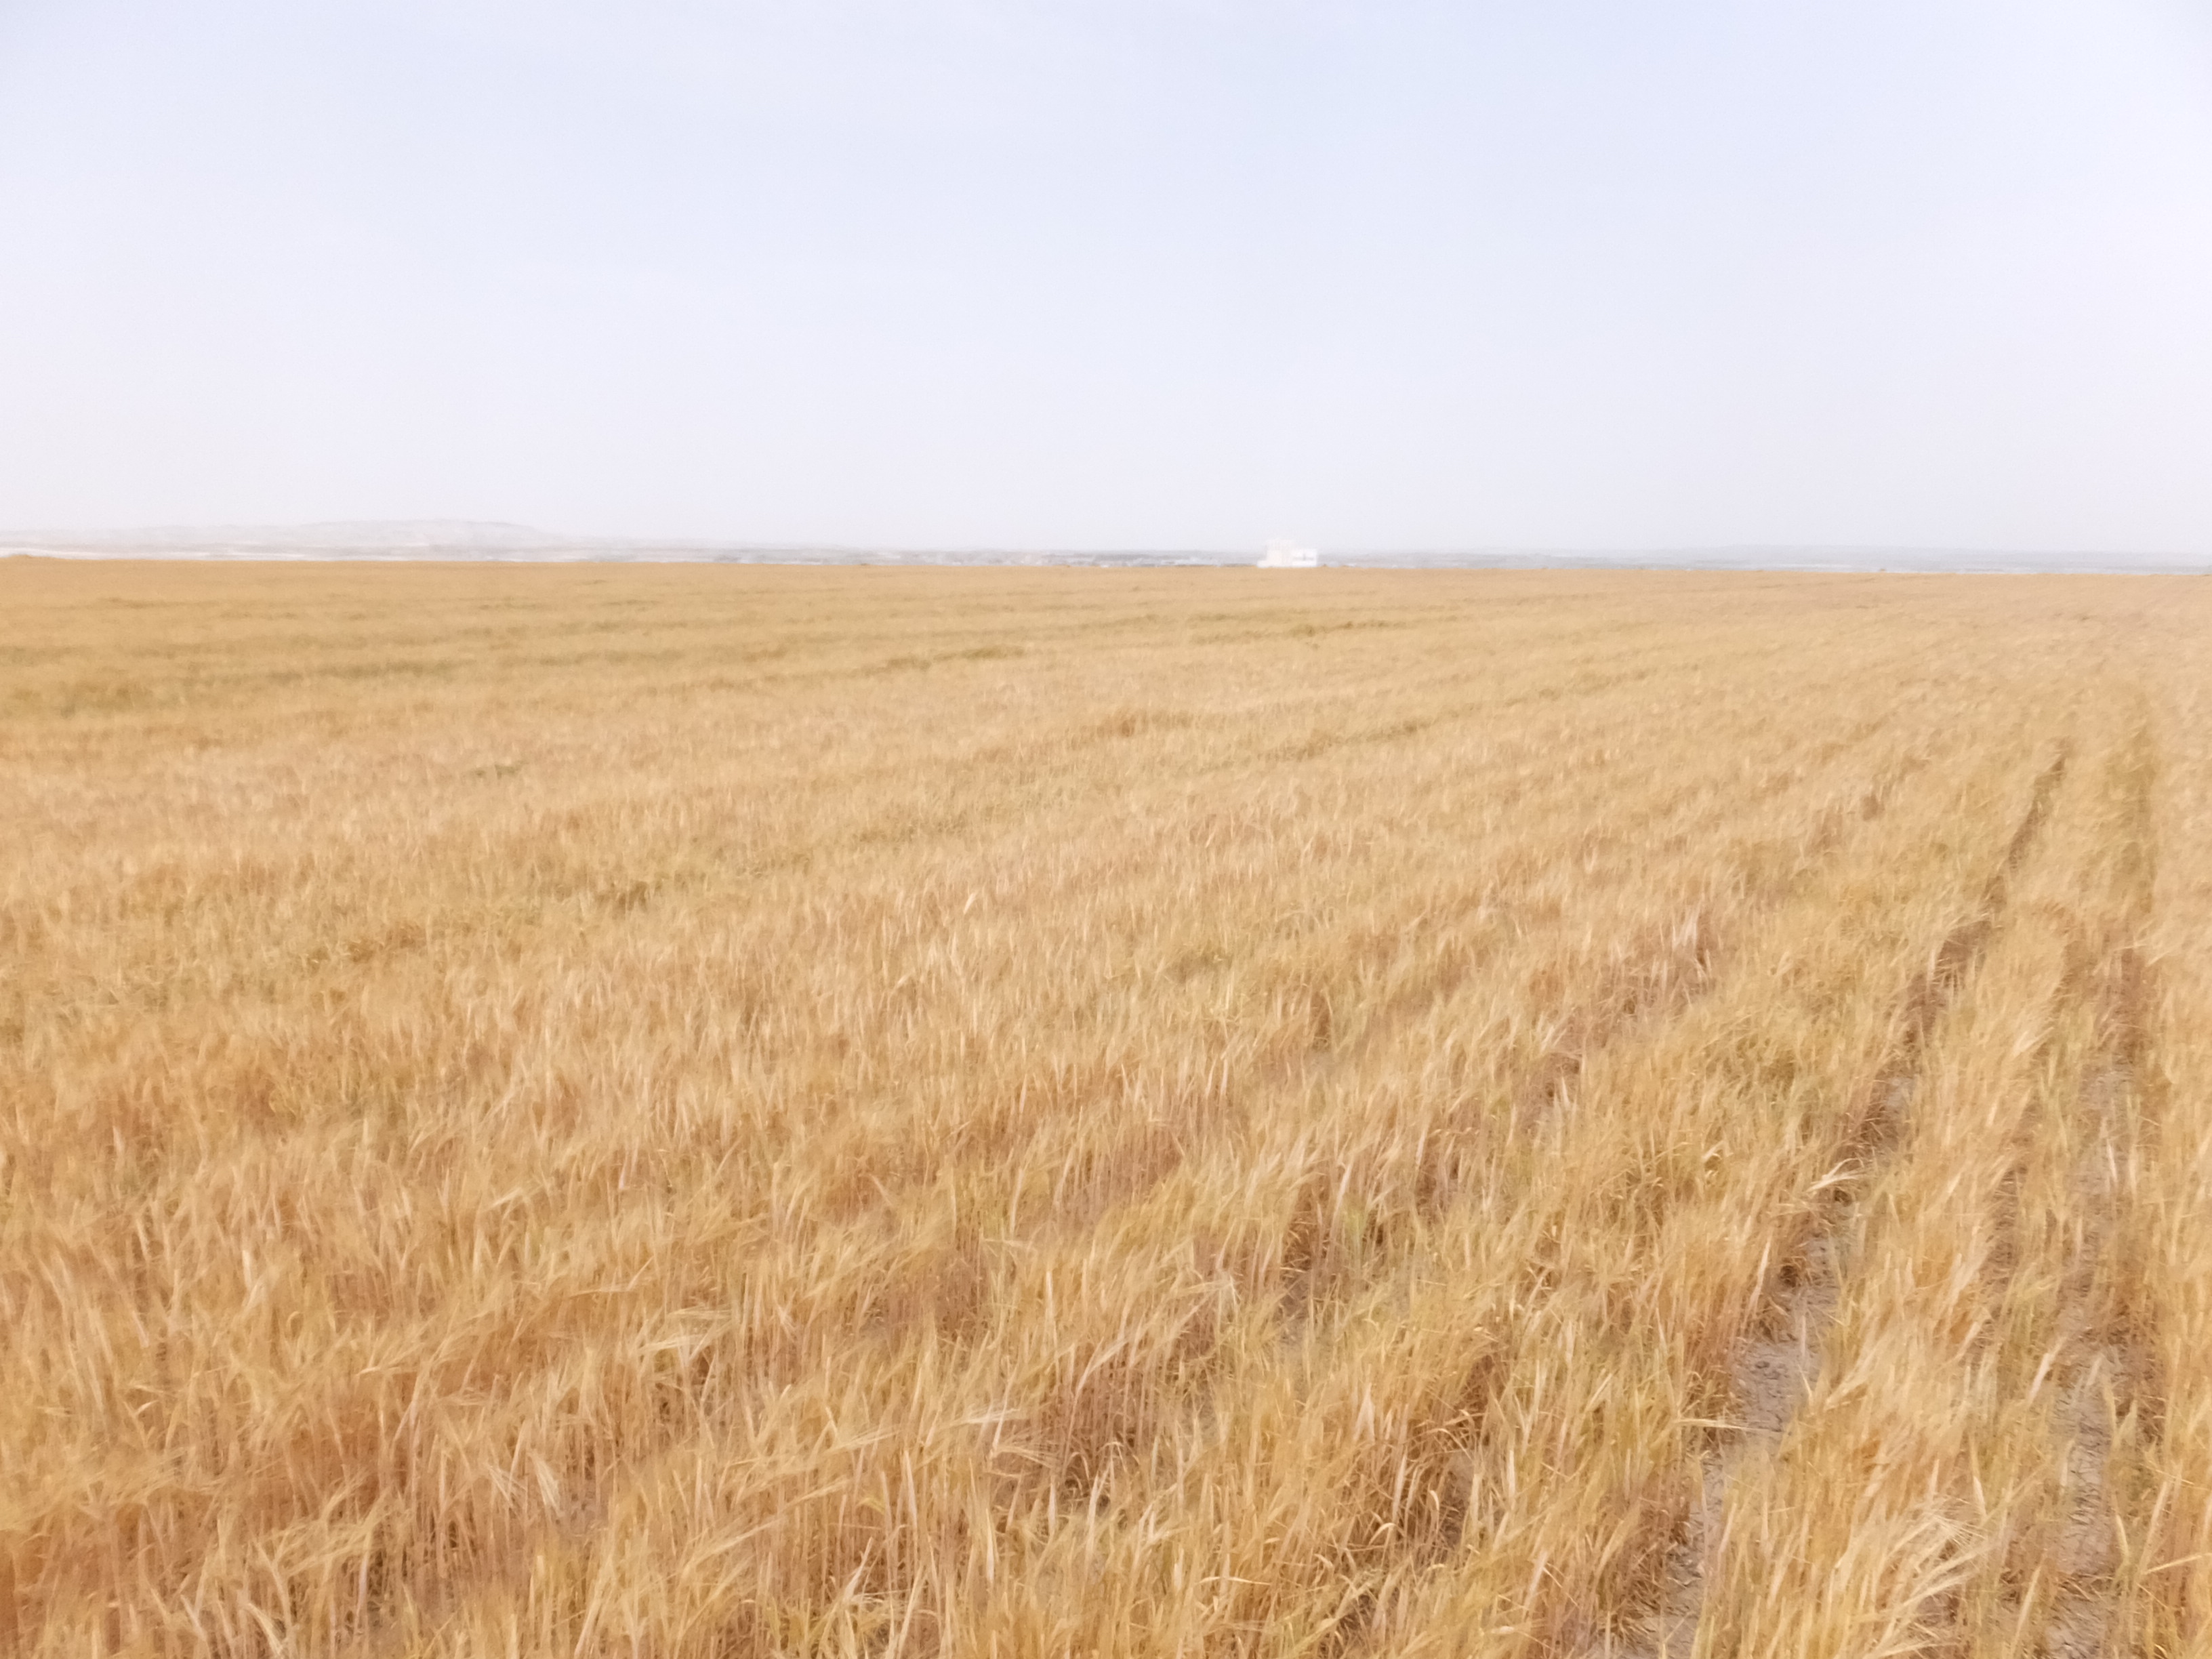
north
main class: Cropland
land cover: Barley
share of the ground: > 75 %
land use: Agriculture (excluding fallow land and kitchen gardens)
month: May
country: ES
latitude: 41.4511
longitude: -0.1540
